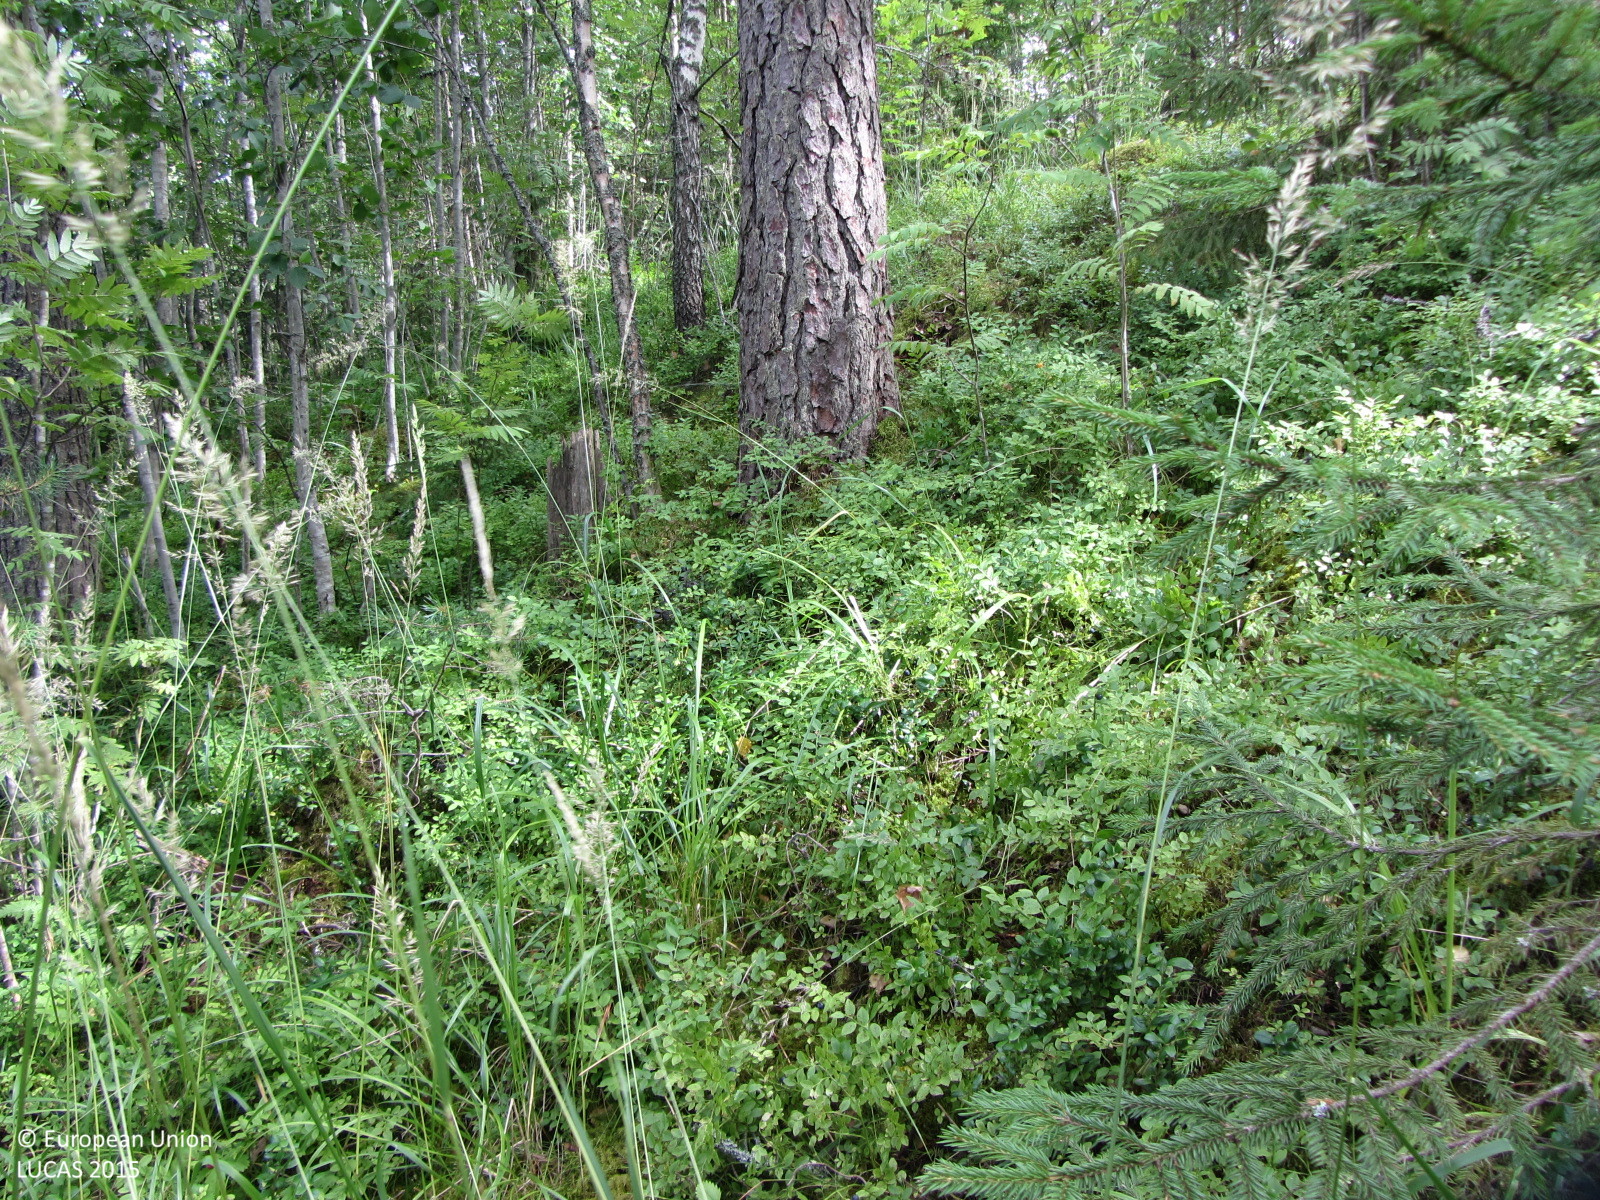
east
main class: Woodland
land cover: Pine dominated mixed woodland
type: boreal forest
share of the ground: 50 - 75 %
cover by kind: broadleaved forest trees 35 %, shrubs 35 %, coniferous forest trees 25 %, herbaceous plants 5 %
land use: Forestry
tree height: > 5 m
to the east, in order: Pine dominated mixed woodland; Ditches and canals; Artificial constructions in urban areas; Grassland without tree/shrub cover; Electric lines; Grassland without tree/shrub cover; Artificial constructions in urban areas; Grassland without tree/shrub cover; Broadleaved woodland; Inland marshes
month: August
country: FI
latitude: 60.6581
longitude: 24.6527
